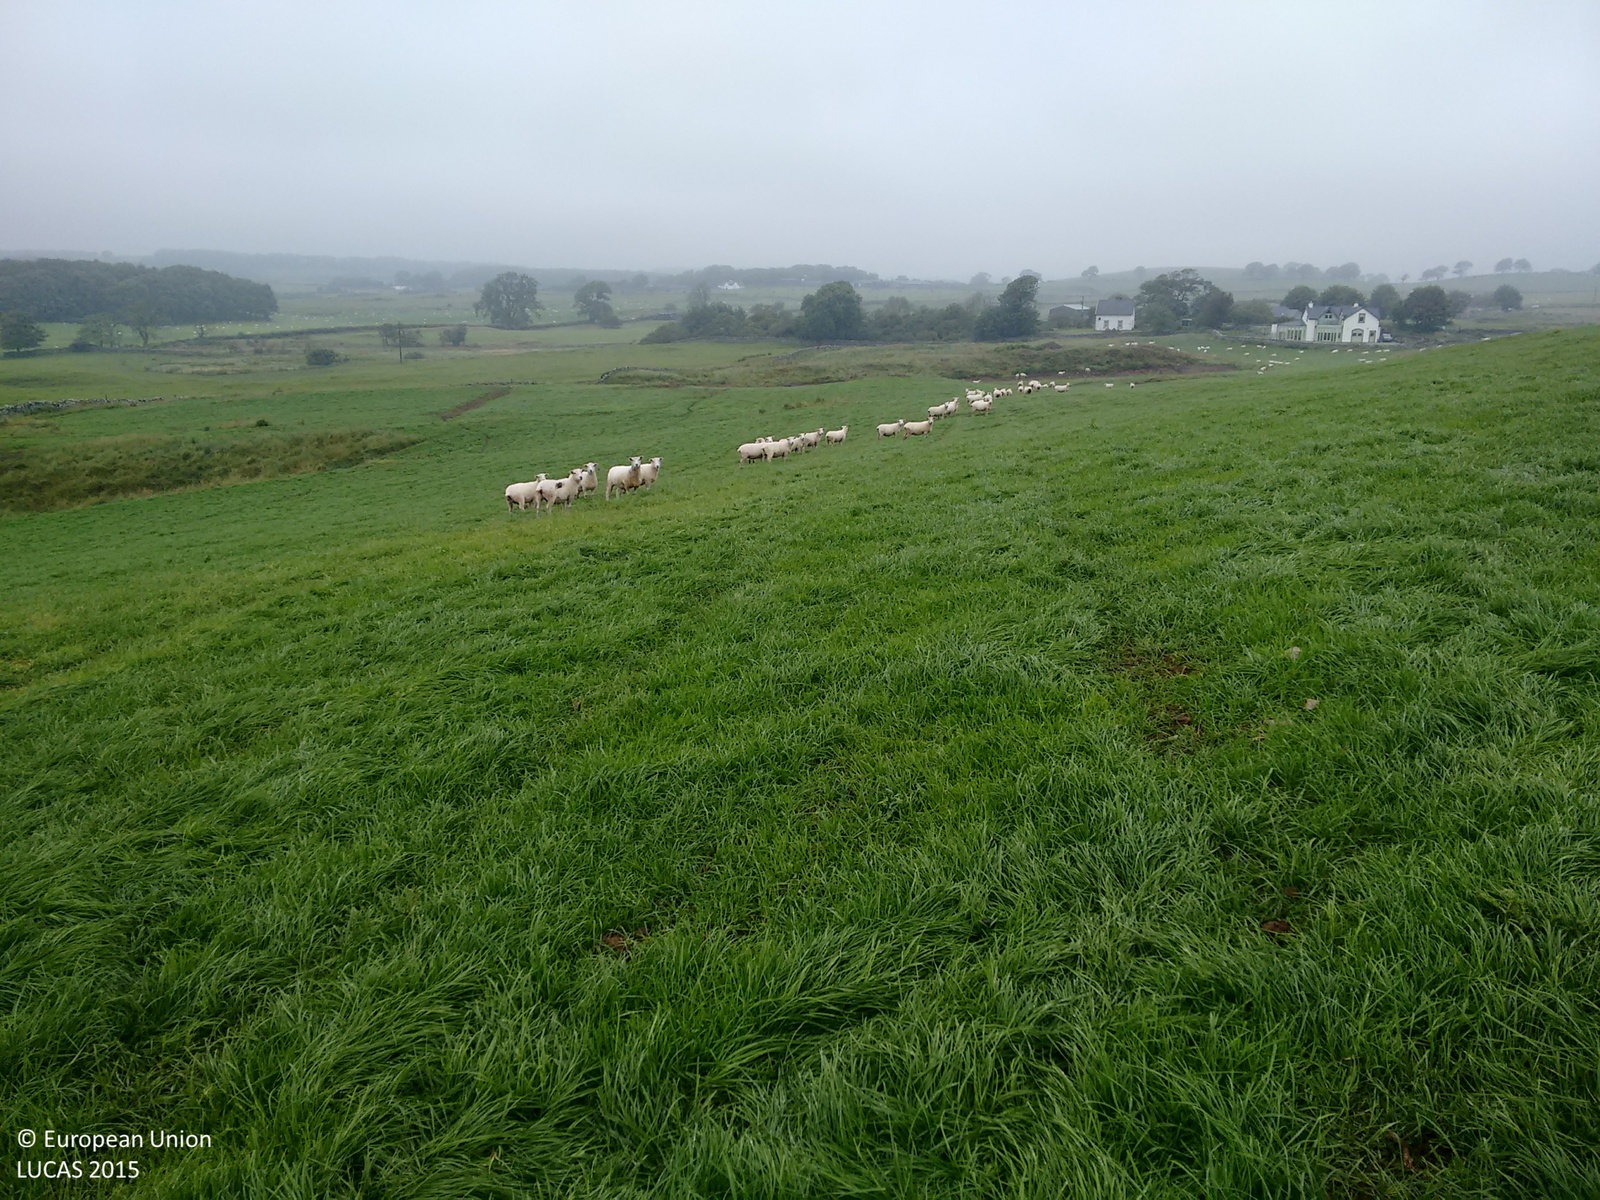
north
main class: Grassland
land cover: Grassland without tree/shrub cover
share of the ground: > 75 %
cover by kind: herbaceous plants 100 %
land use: Agriculture (excluding fallow land and kitchen gardens)
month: July
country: GB
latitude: 54.7994
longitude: -4.1091
